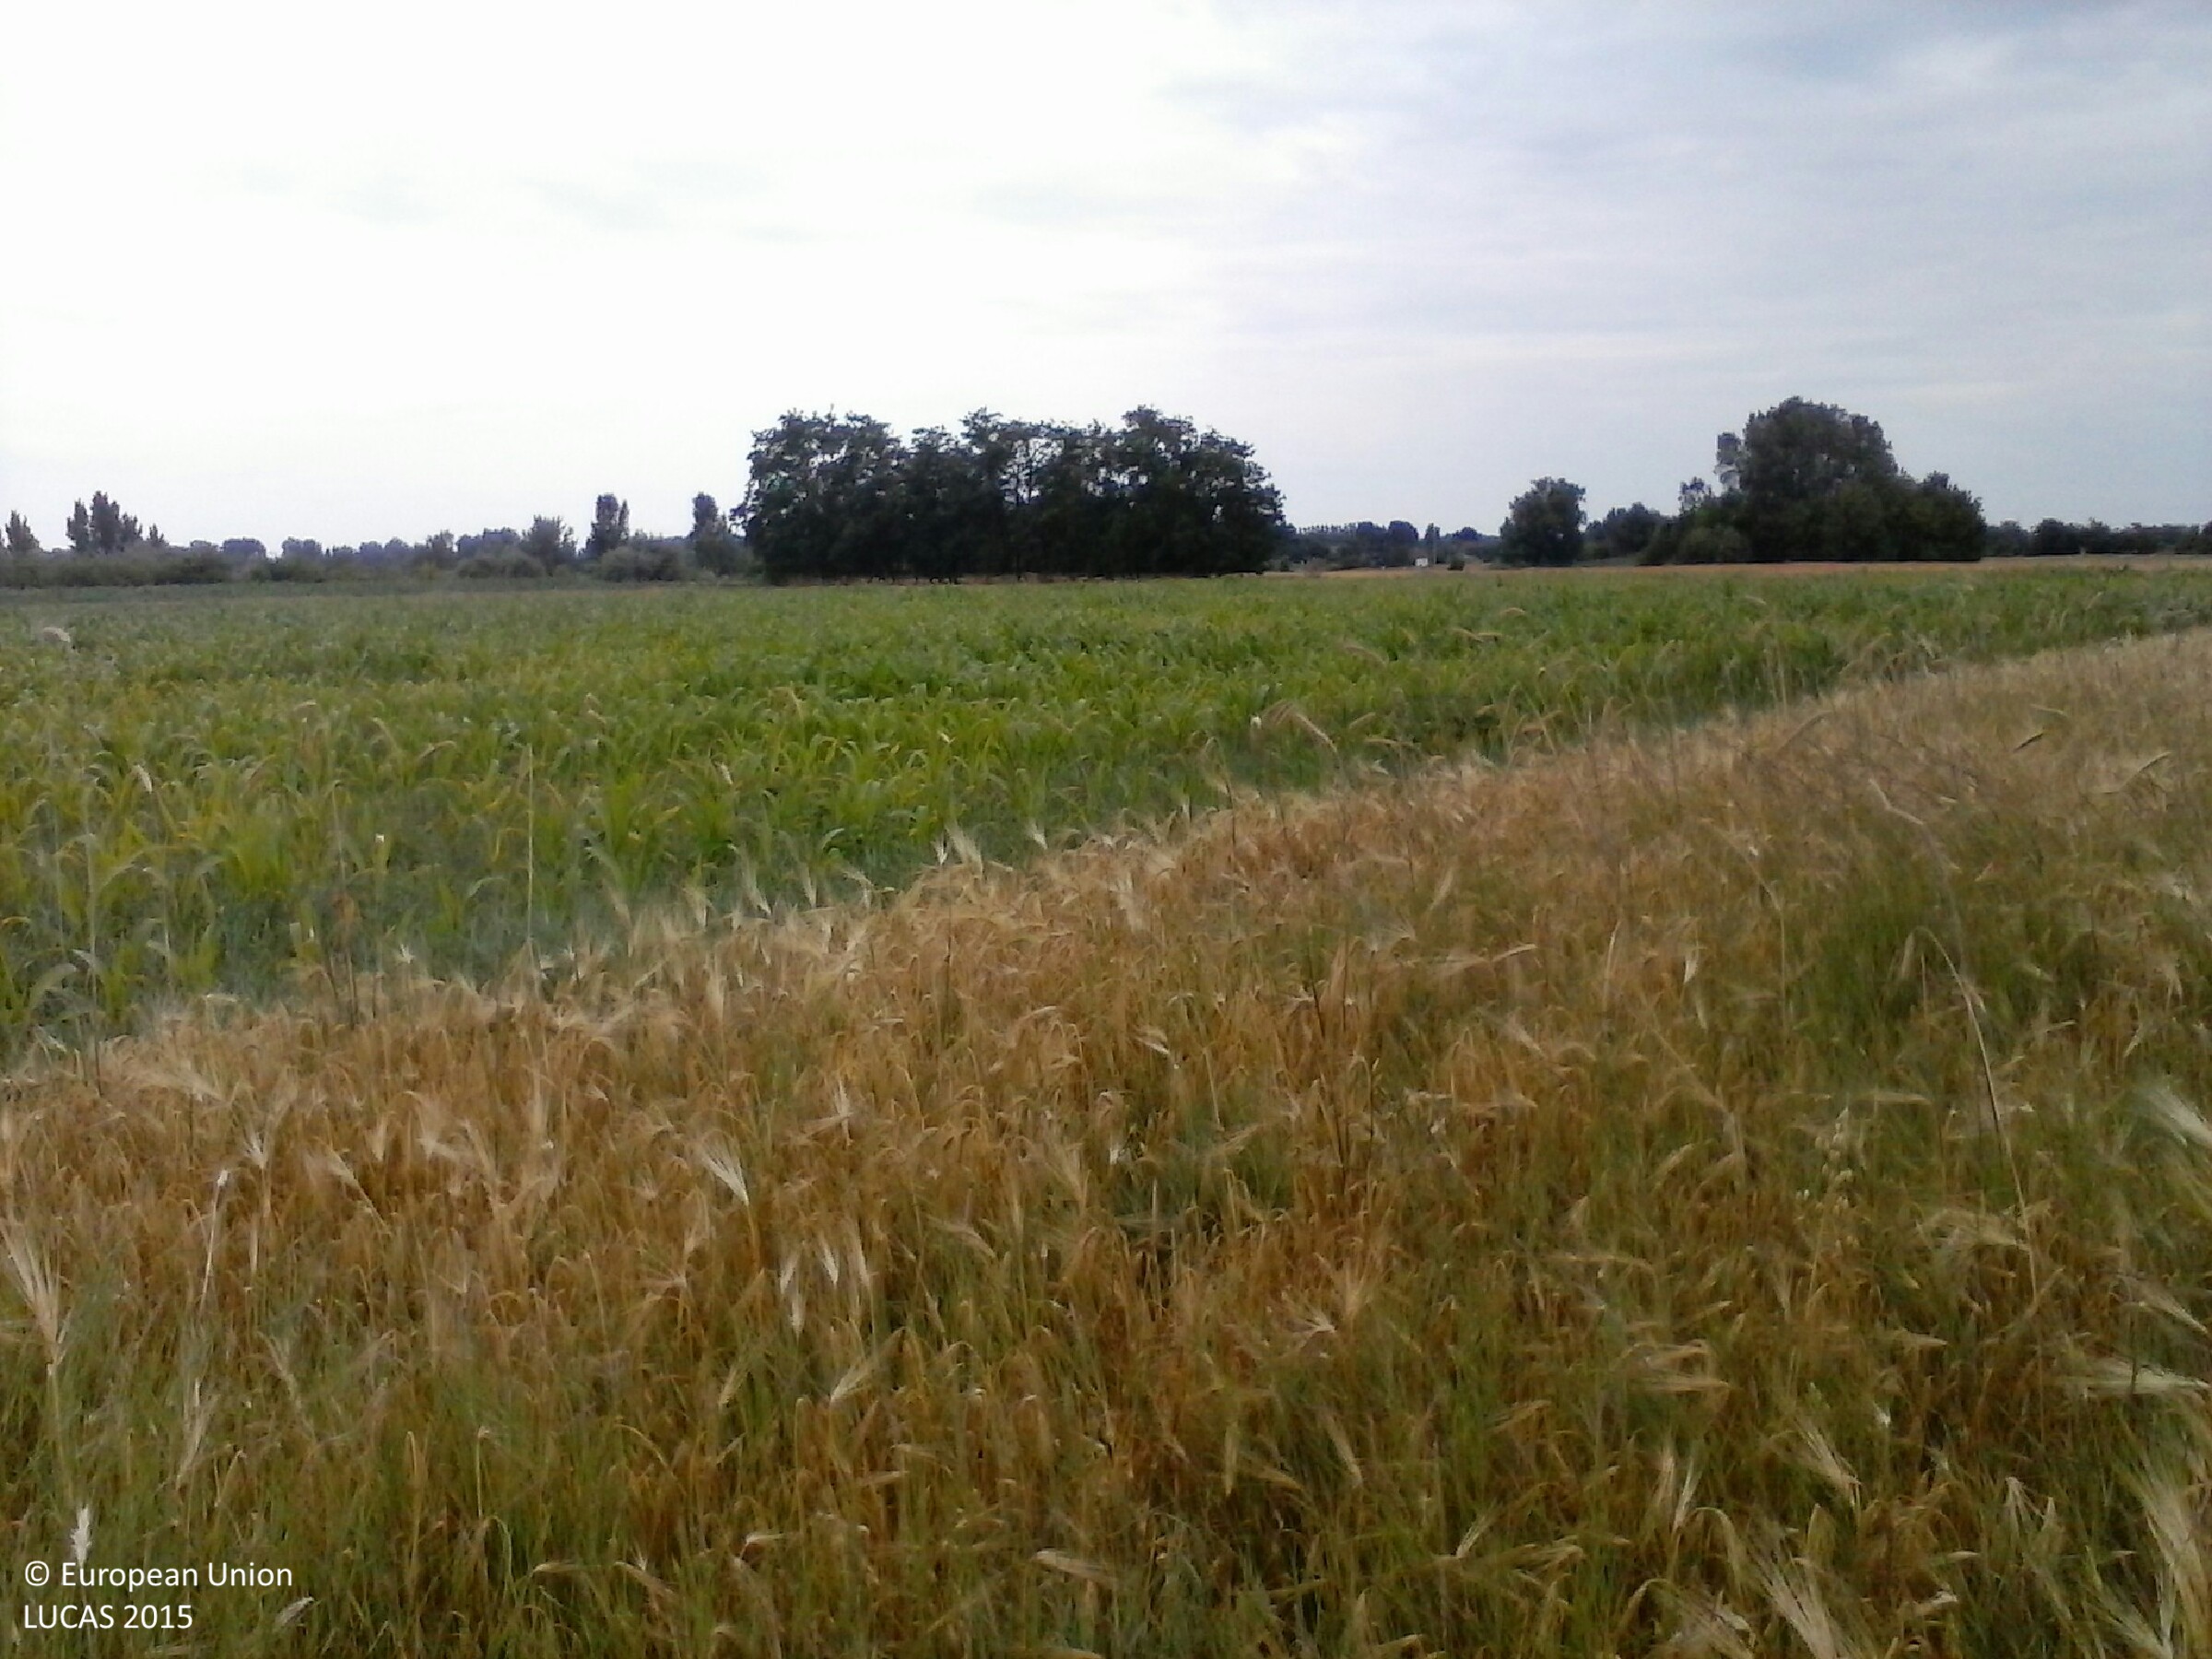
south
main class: Cropland
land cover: Barley
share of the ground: > 75 %
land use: Agriculture (excluding fallow land and kitchen gardens)
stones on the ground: < 10 %
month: June
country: HU
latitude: 46.3162
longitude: 20.0076
